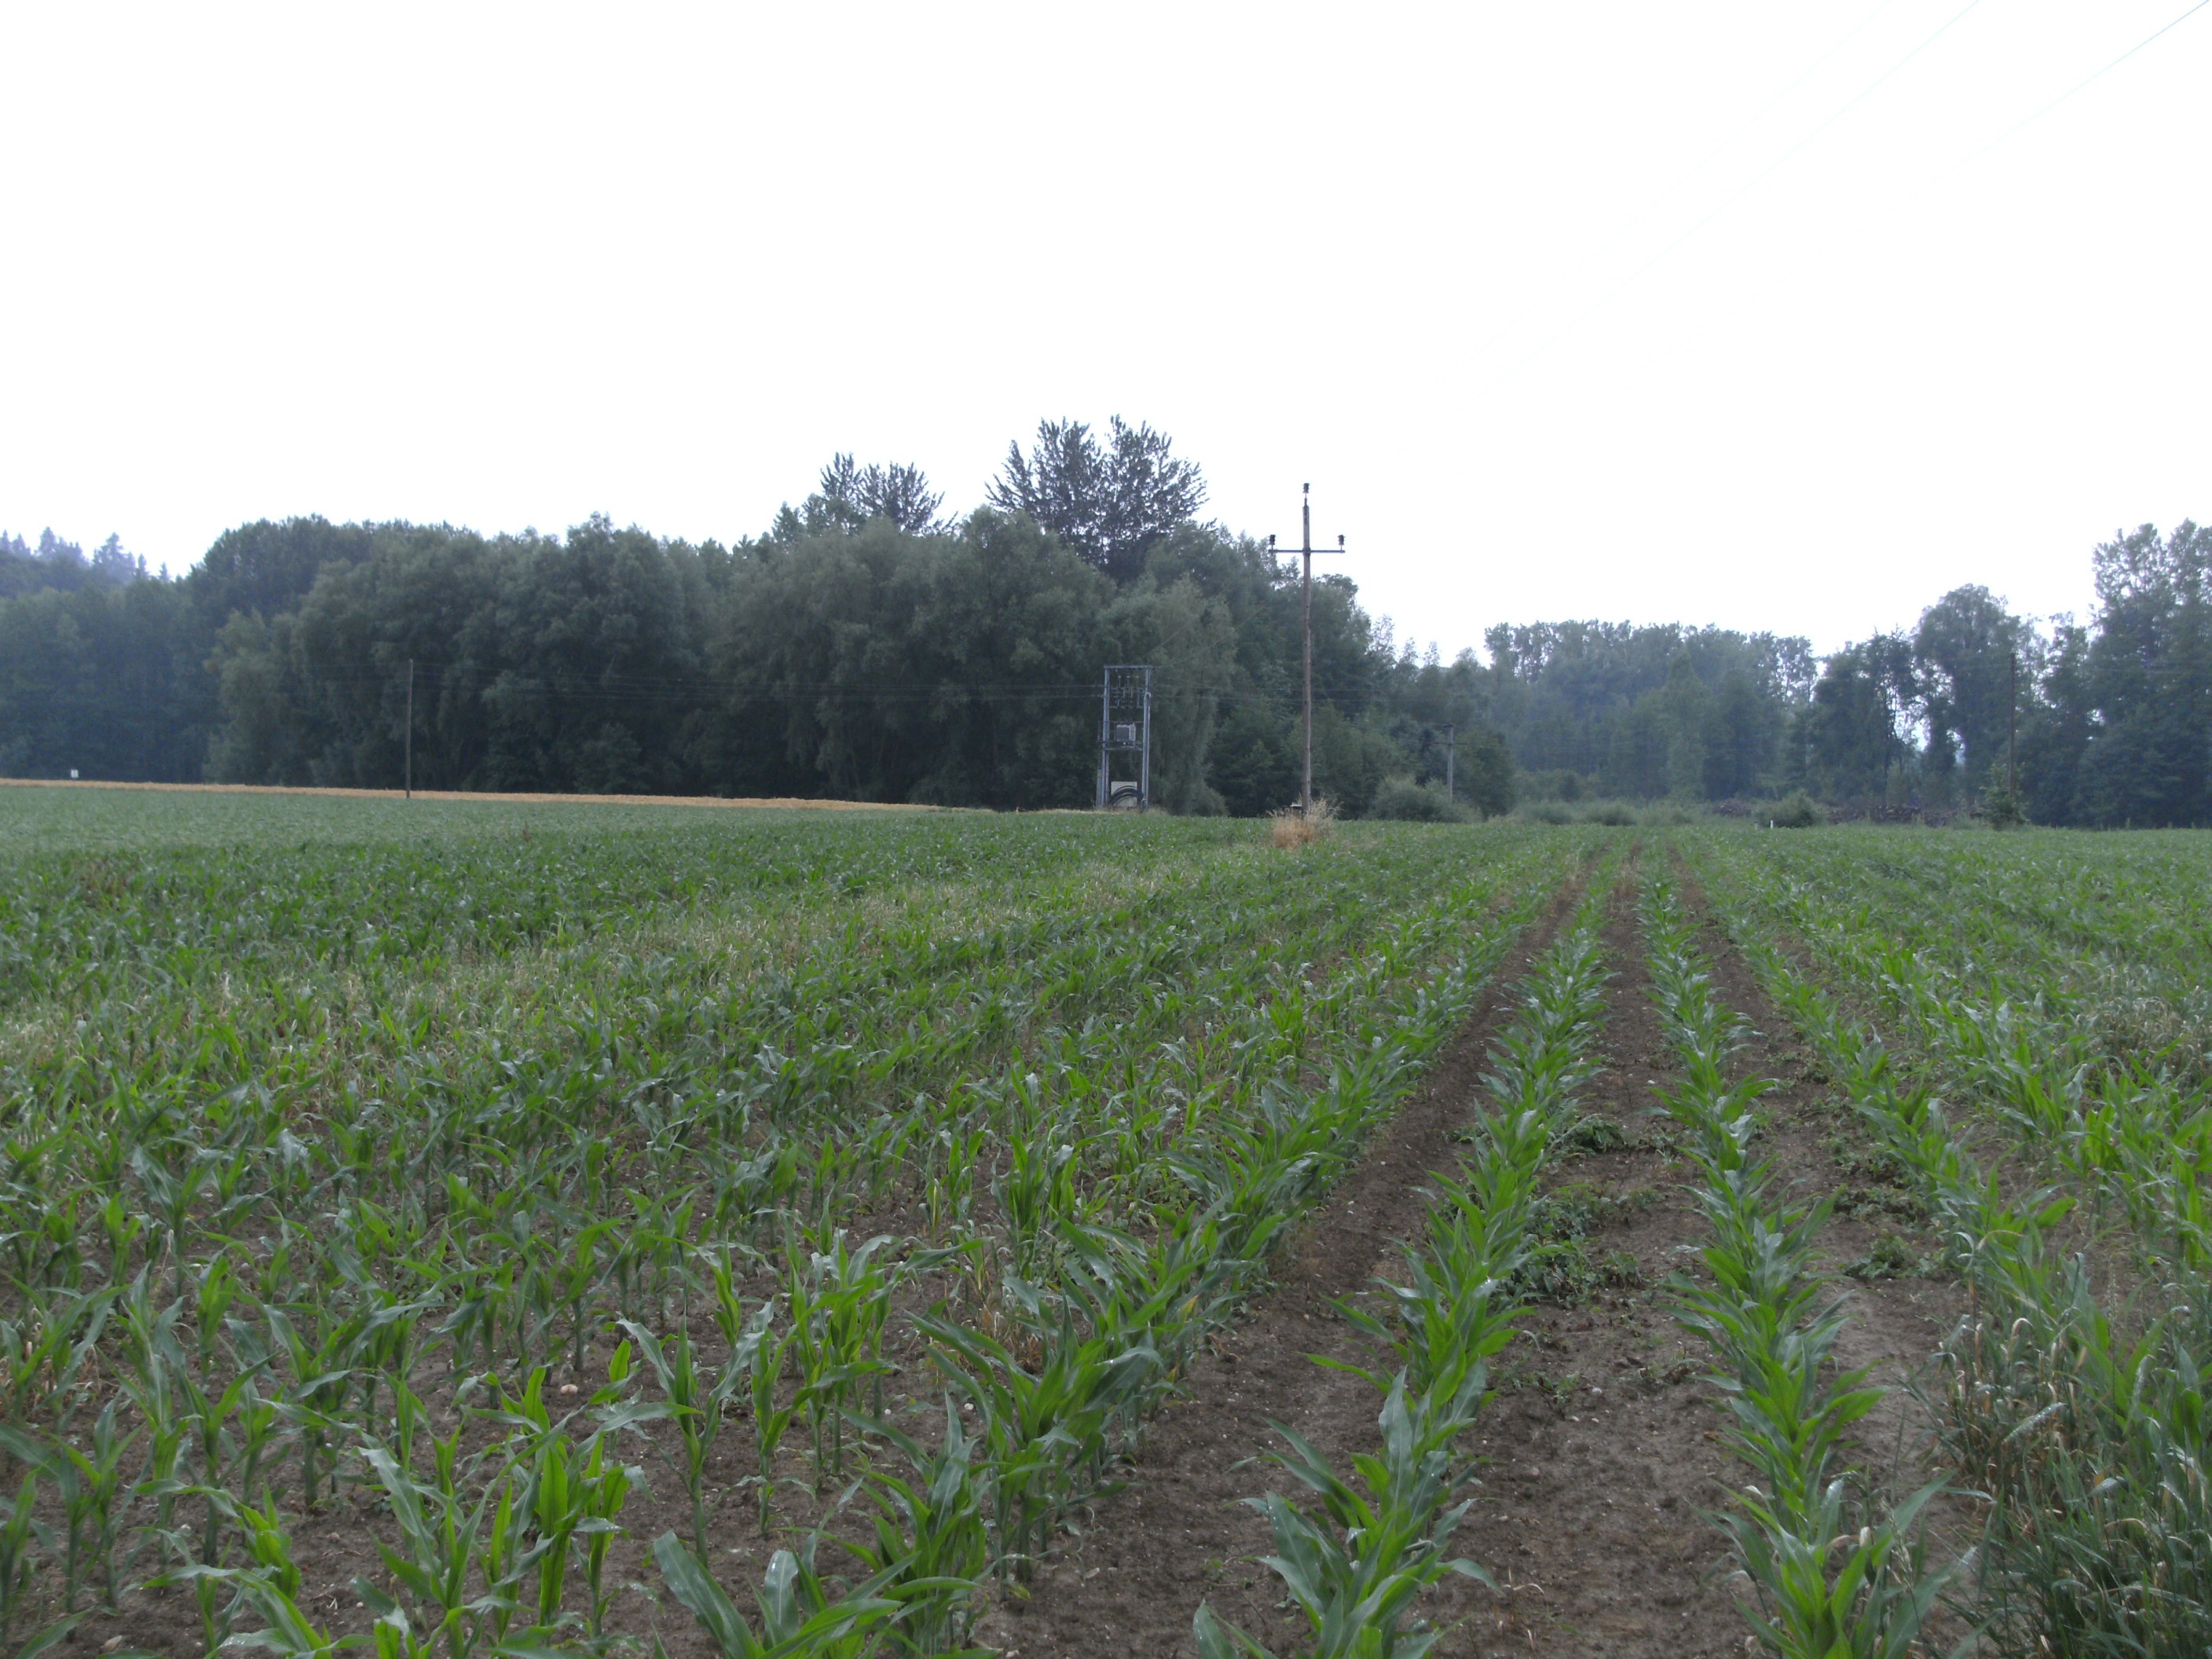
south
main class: Cropland
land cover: Maize
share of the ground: 25 - 50 %
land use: Agriculture (excluding fallow land and kitchen gardens)
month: June
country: AT
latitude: 48.3449
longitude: 14.1152
